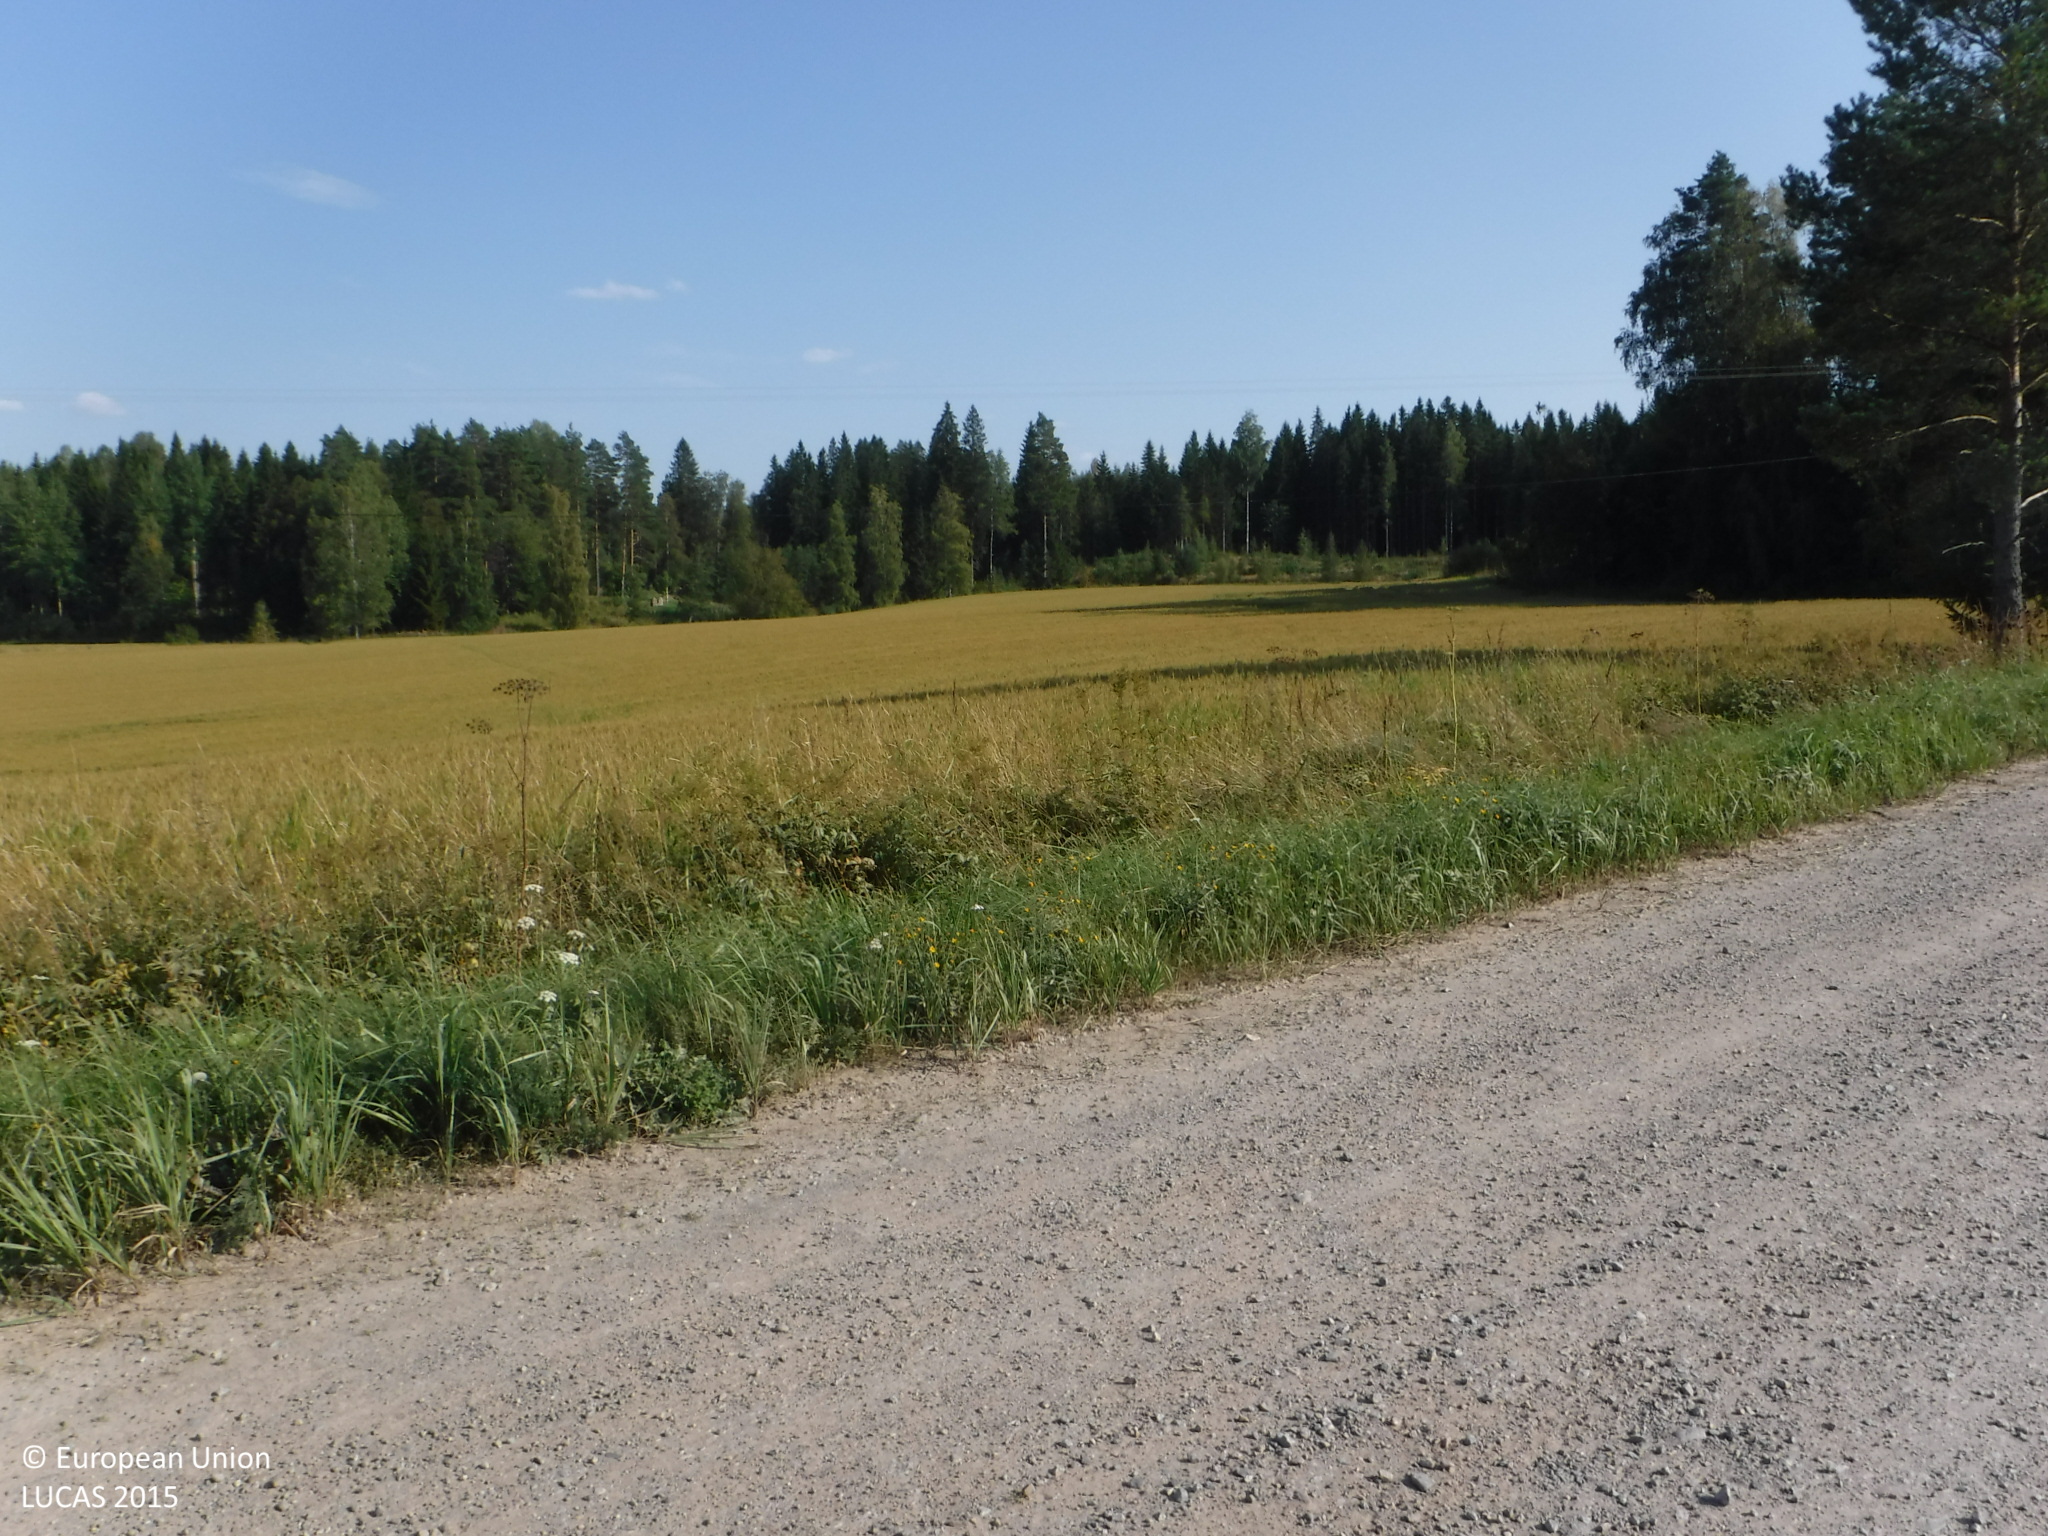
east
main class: Woodland
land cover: Other mixed woodland
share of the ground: > 75 %
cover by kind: coniferous forest trees 50 %, broadleaved forest trees 30 %, shrubs 10 %, herbaceous plants 10 %
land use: Semi-natural and natural areas not in use
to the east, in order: Other mixed woodland; Rye; Grass margins; Ditches and canals; Grass margins; Paved roads, cycling and walking lanes; Grass margins; Ditches and canals; Grass margins; Common wheat; Electric lines; Common wheat; Grass margins; Ditches and canals; Grass margins; Common wheat
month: August
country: FI
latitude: 61.2283
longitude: 23.1310
